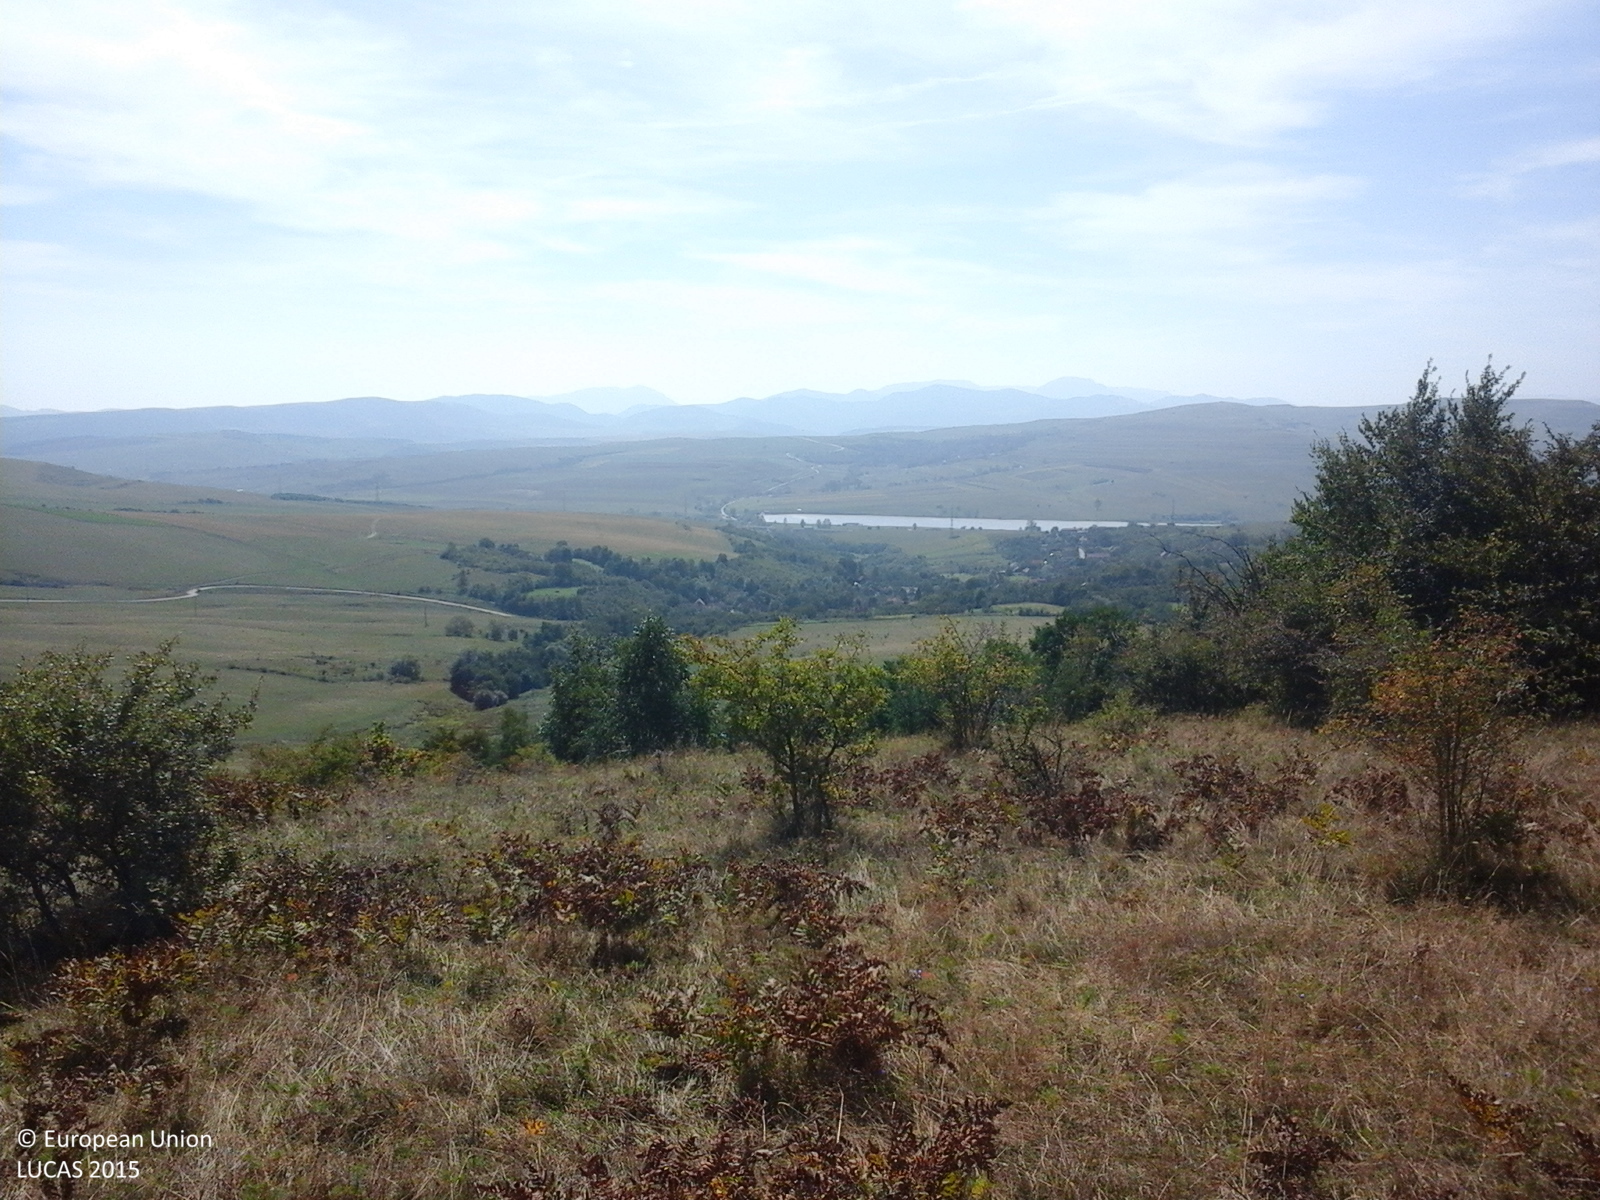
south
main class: Grassland
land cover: Grassland with sparse tree/shrub cover
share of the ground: > 75 %
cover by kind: herbaceous plants 85 %, shrubs 10 %, broadleaved forest trees 5 %
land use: Agriculture (excluding fallow land and kitchen gardens)
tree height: > 5 m
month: September
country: RO
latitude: 46.6501
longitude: 23.5673
